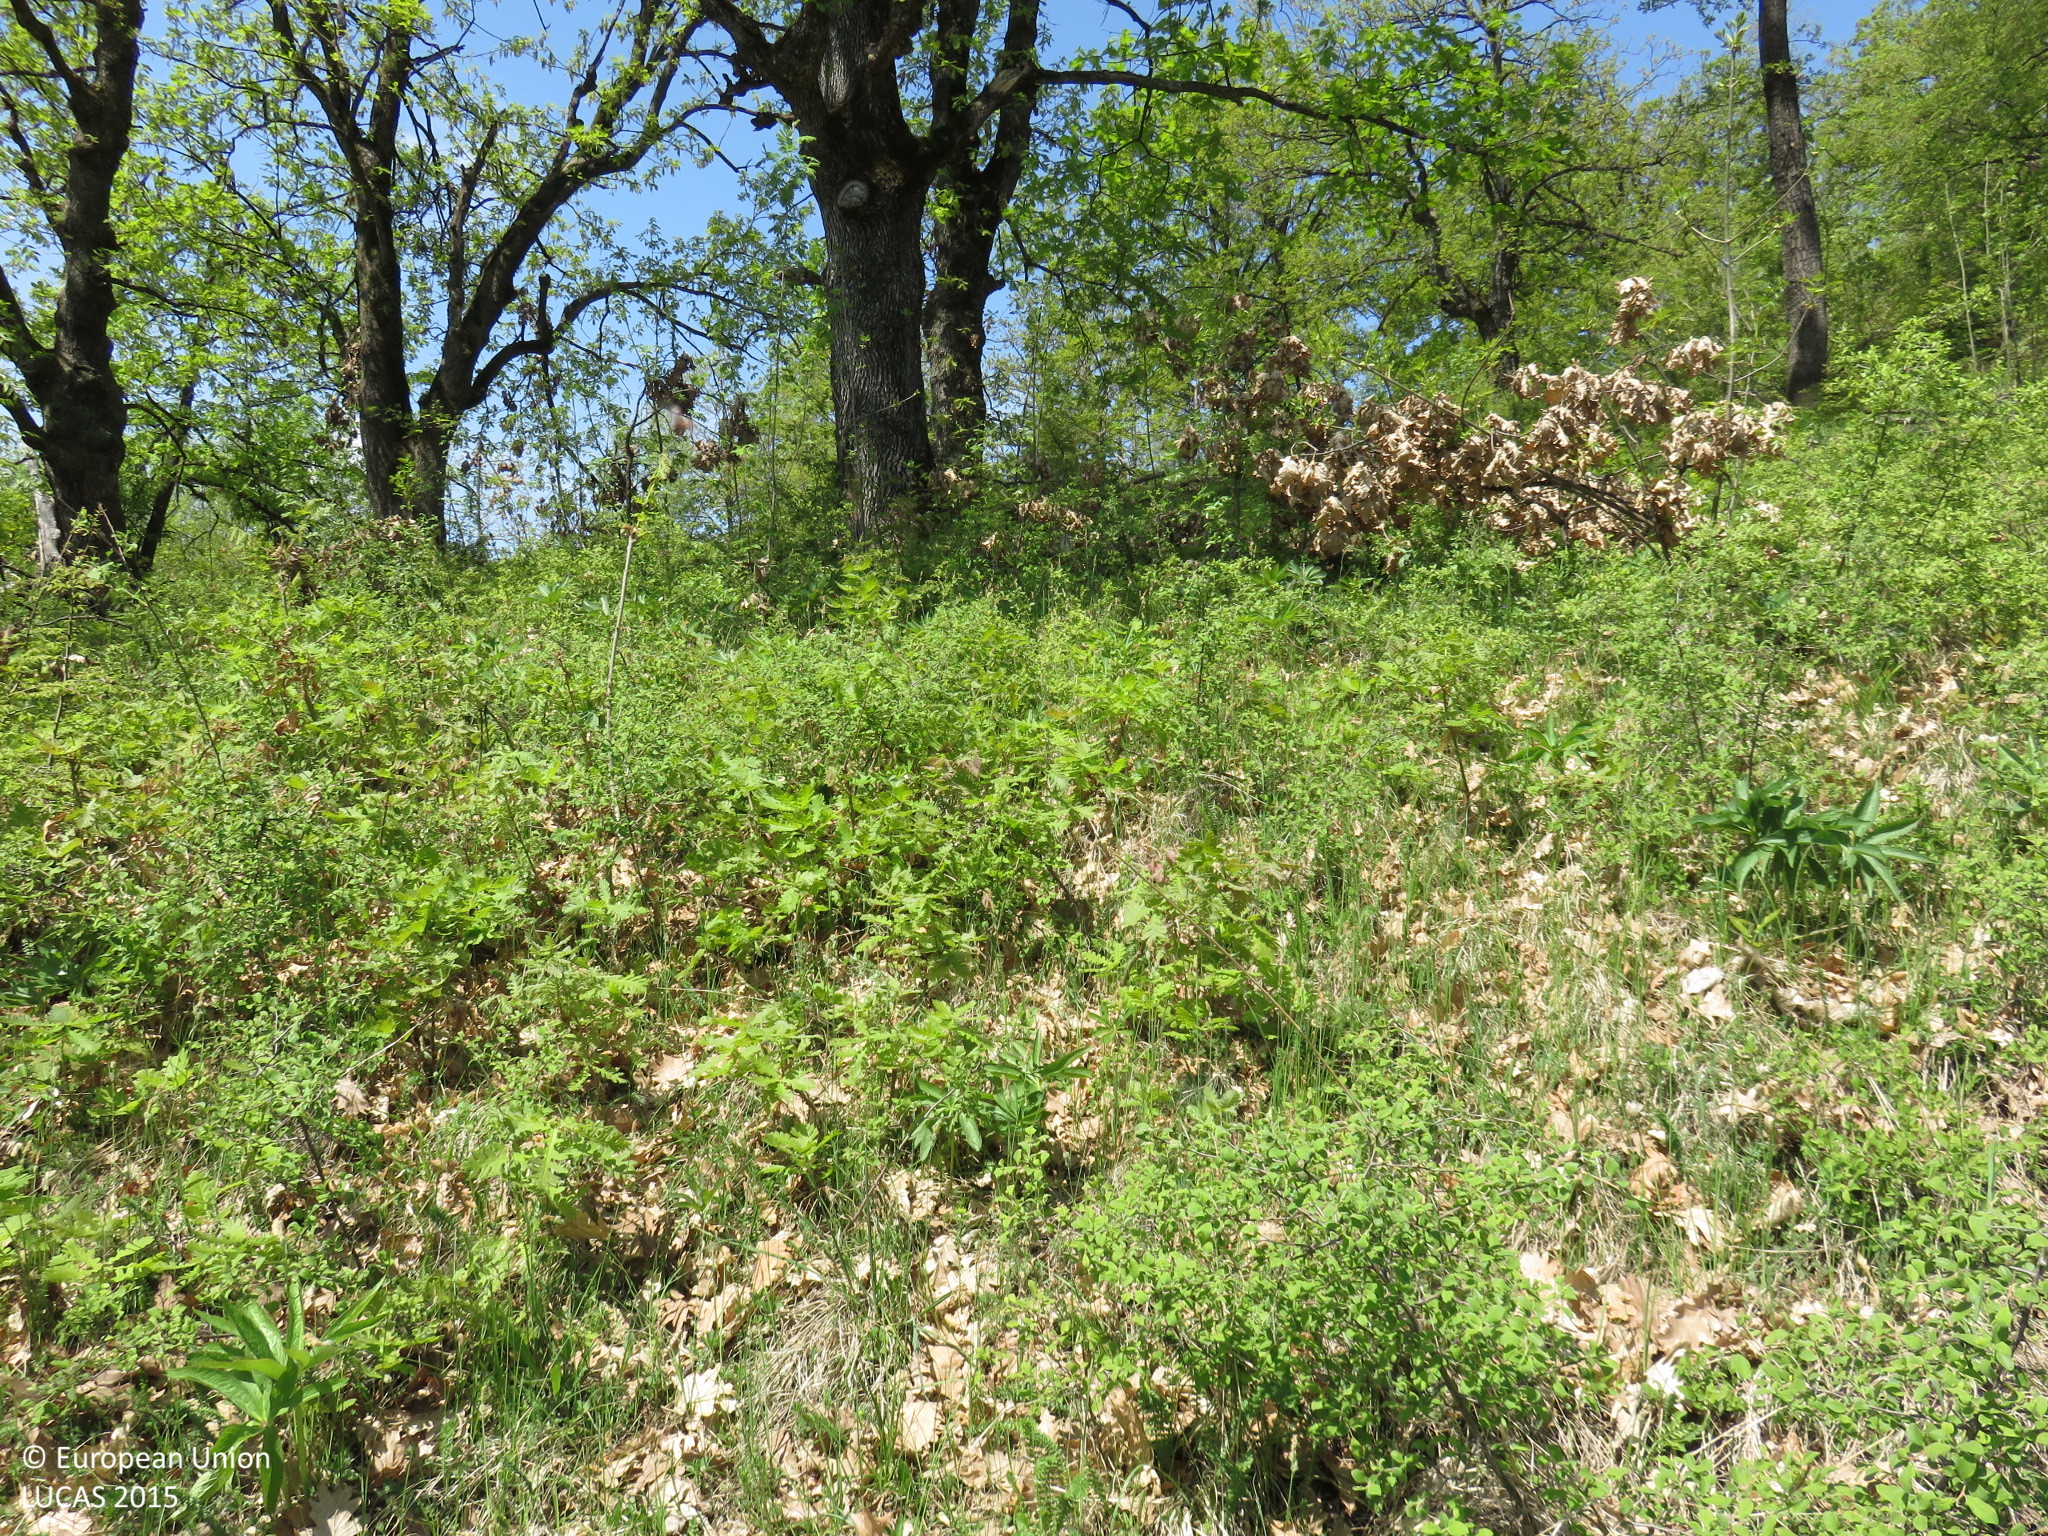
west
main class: Woodland
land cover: Broadleaved woodland
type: mesophytic deciduous forest
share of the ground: 50 - 75 %
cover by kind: broadleaved forest trees 55 %, shrubs 40 %, herbaceous plants 5 %
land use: Semi-natural and natural areas not in use
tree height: < 5 m
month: April
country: BG
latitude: 43.0293
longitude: 24.7767
